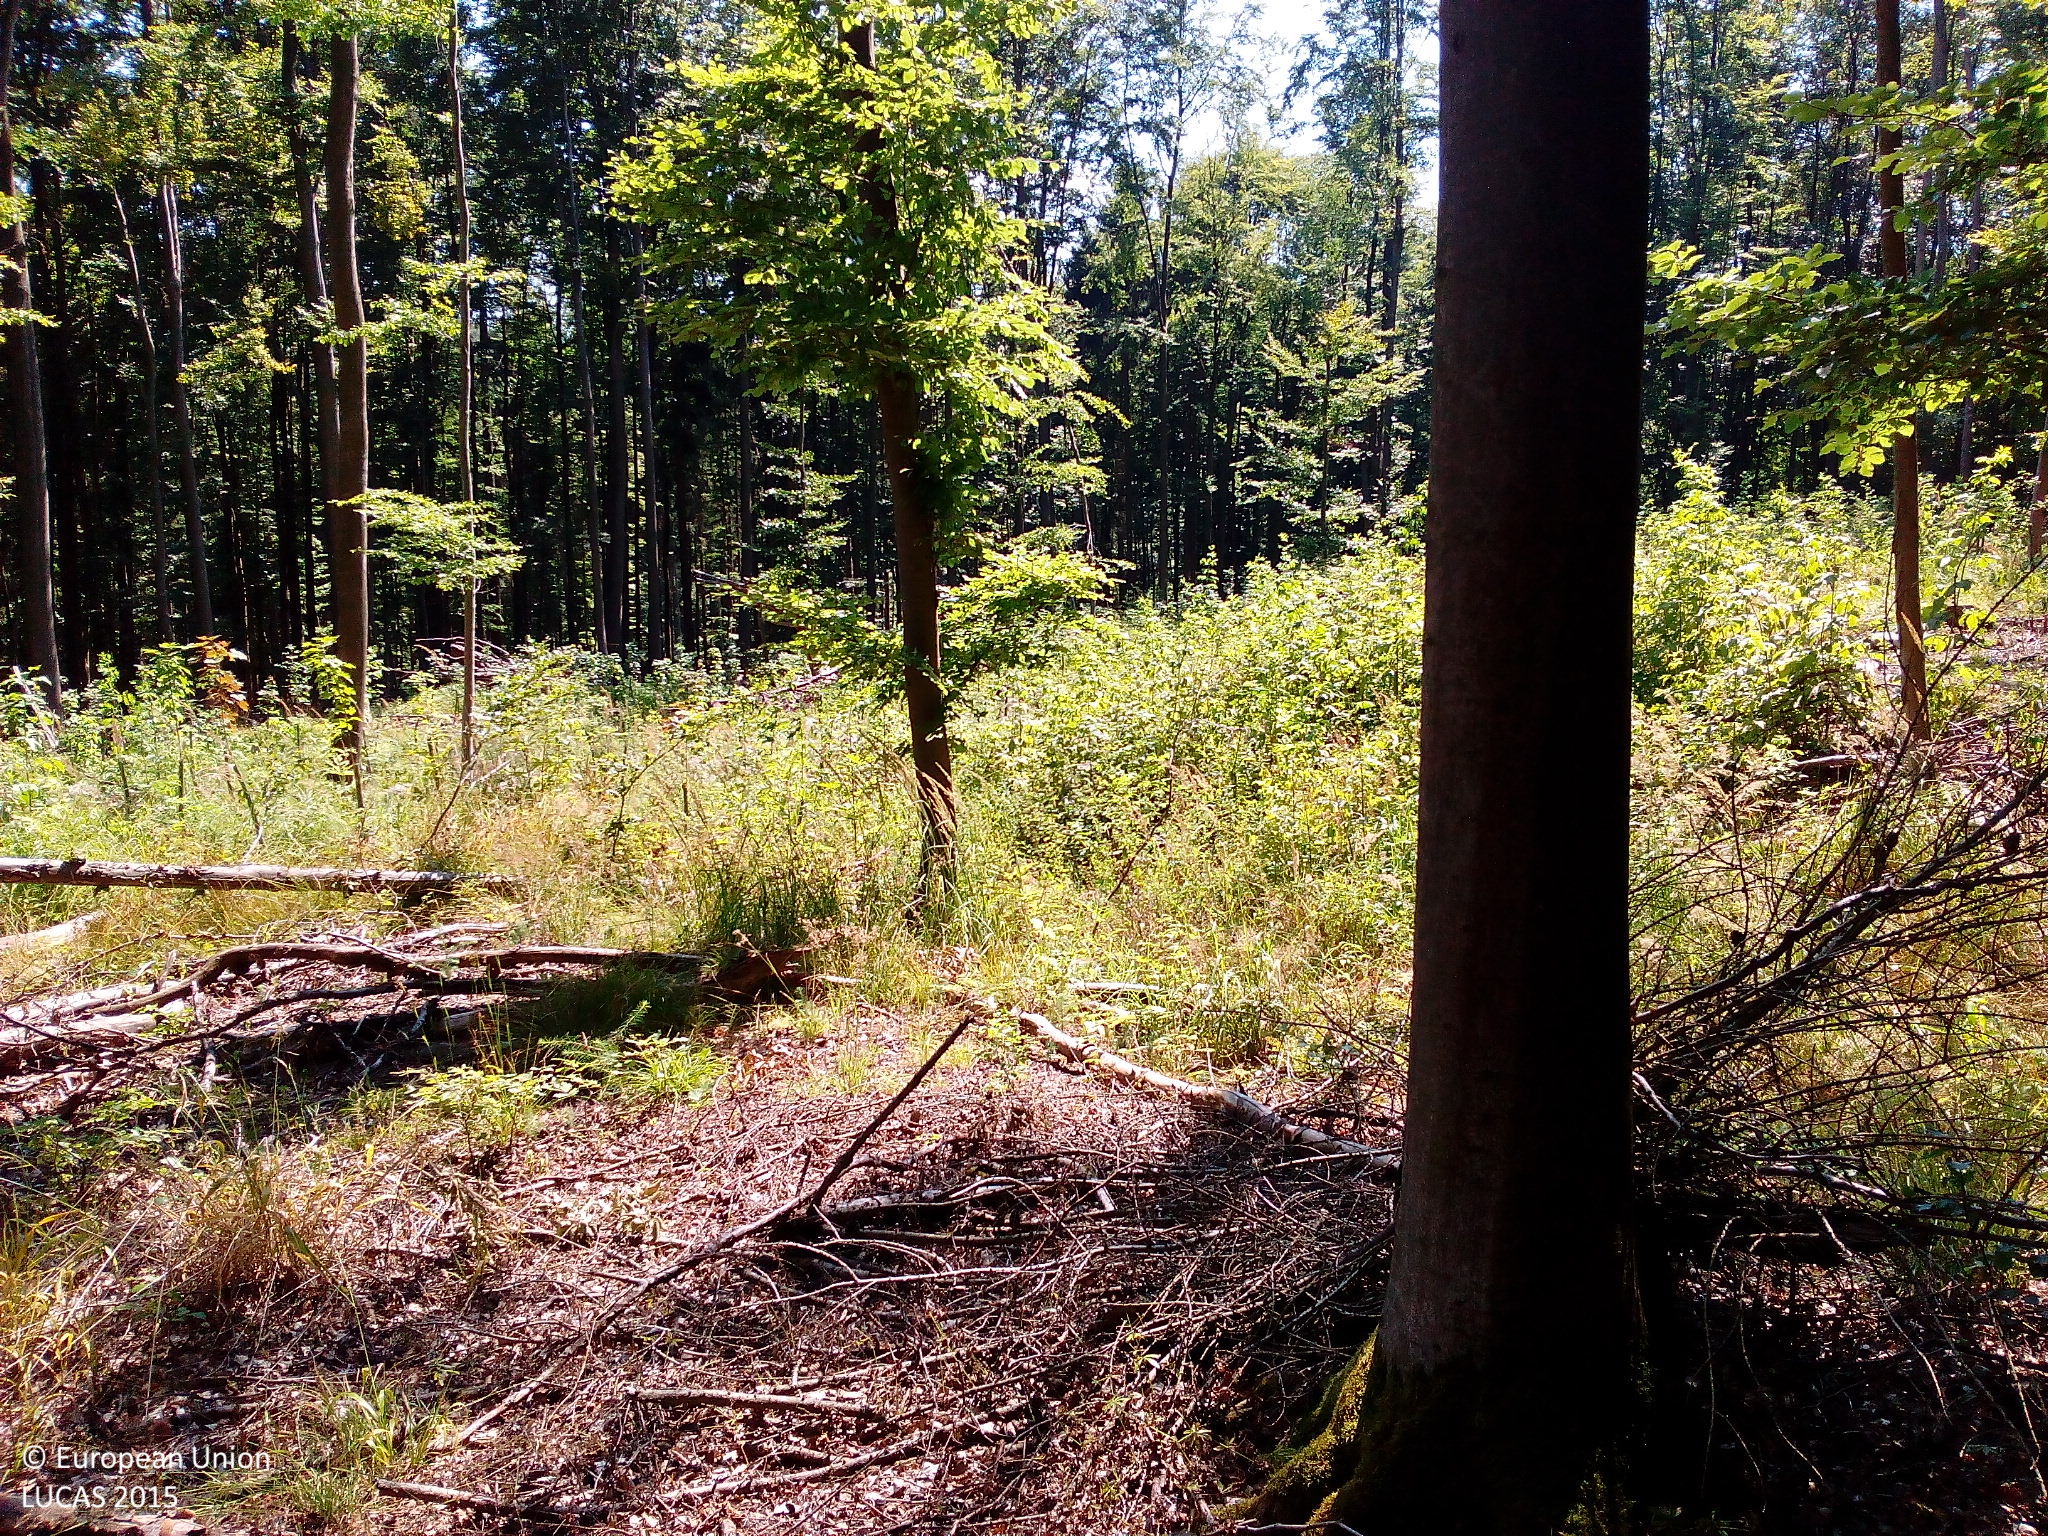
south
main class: Woodland
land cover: Broadleaved woodland
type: beech forest
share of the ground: > 75 %
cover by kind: broadleaved forest trees 90 %, herbaceous plants 5 %, unconsolidated bare surface 5 %
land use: Forestry
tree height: > 5 m
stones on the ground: < 10 %
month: August
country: DE
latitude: 50.7397
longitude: 9.3342
